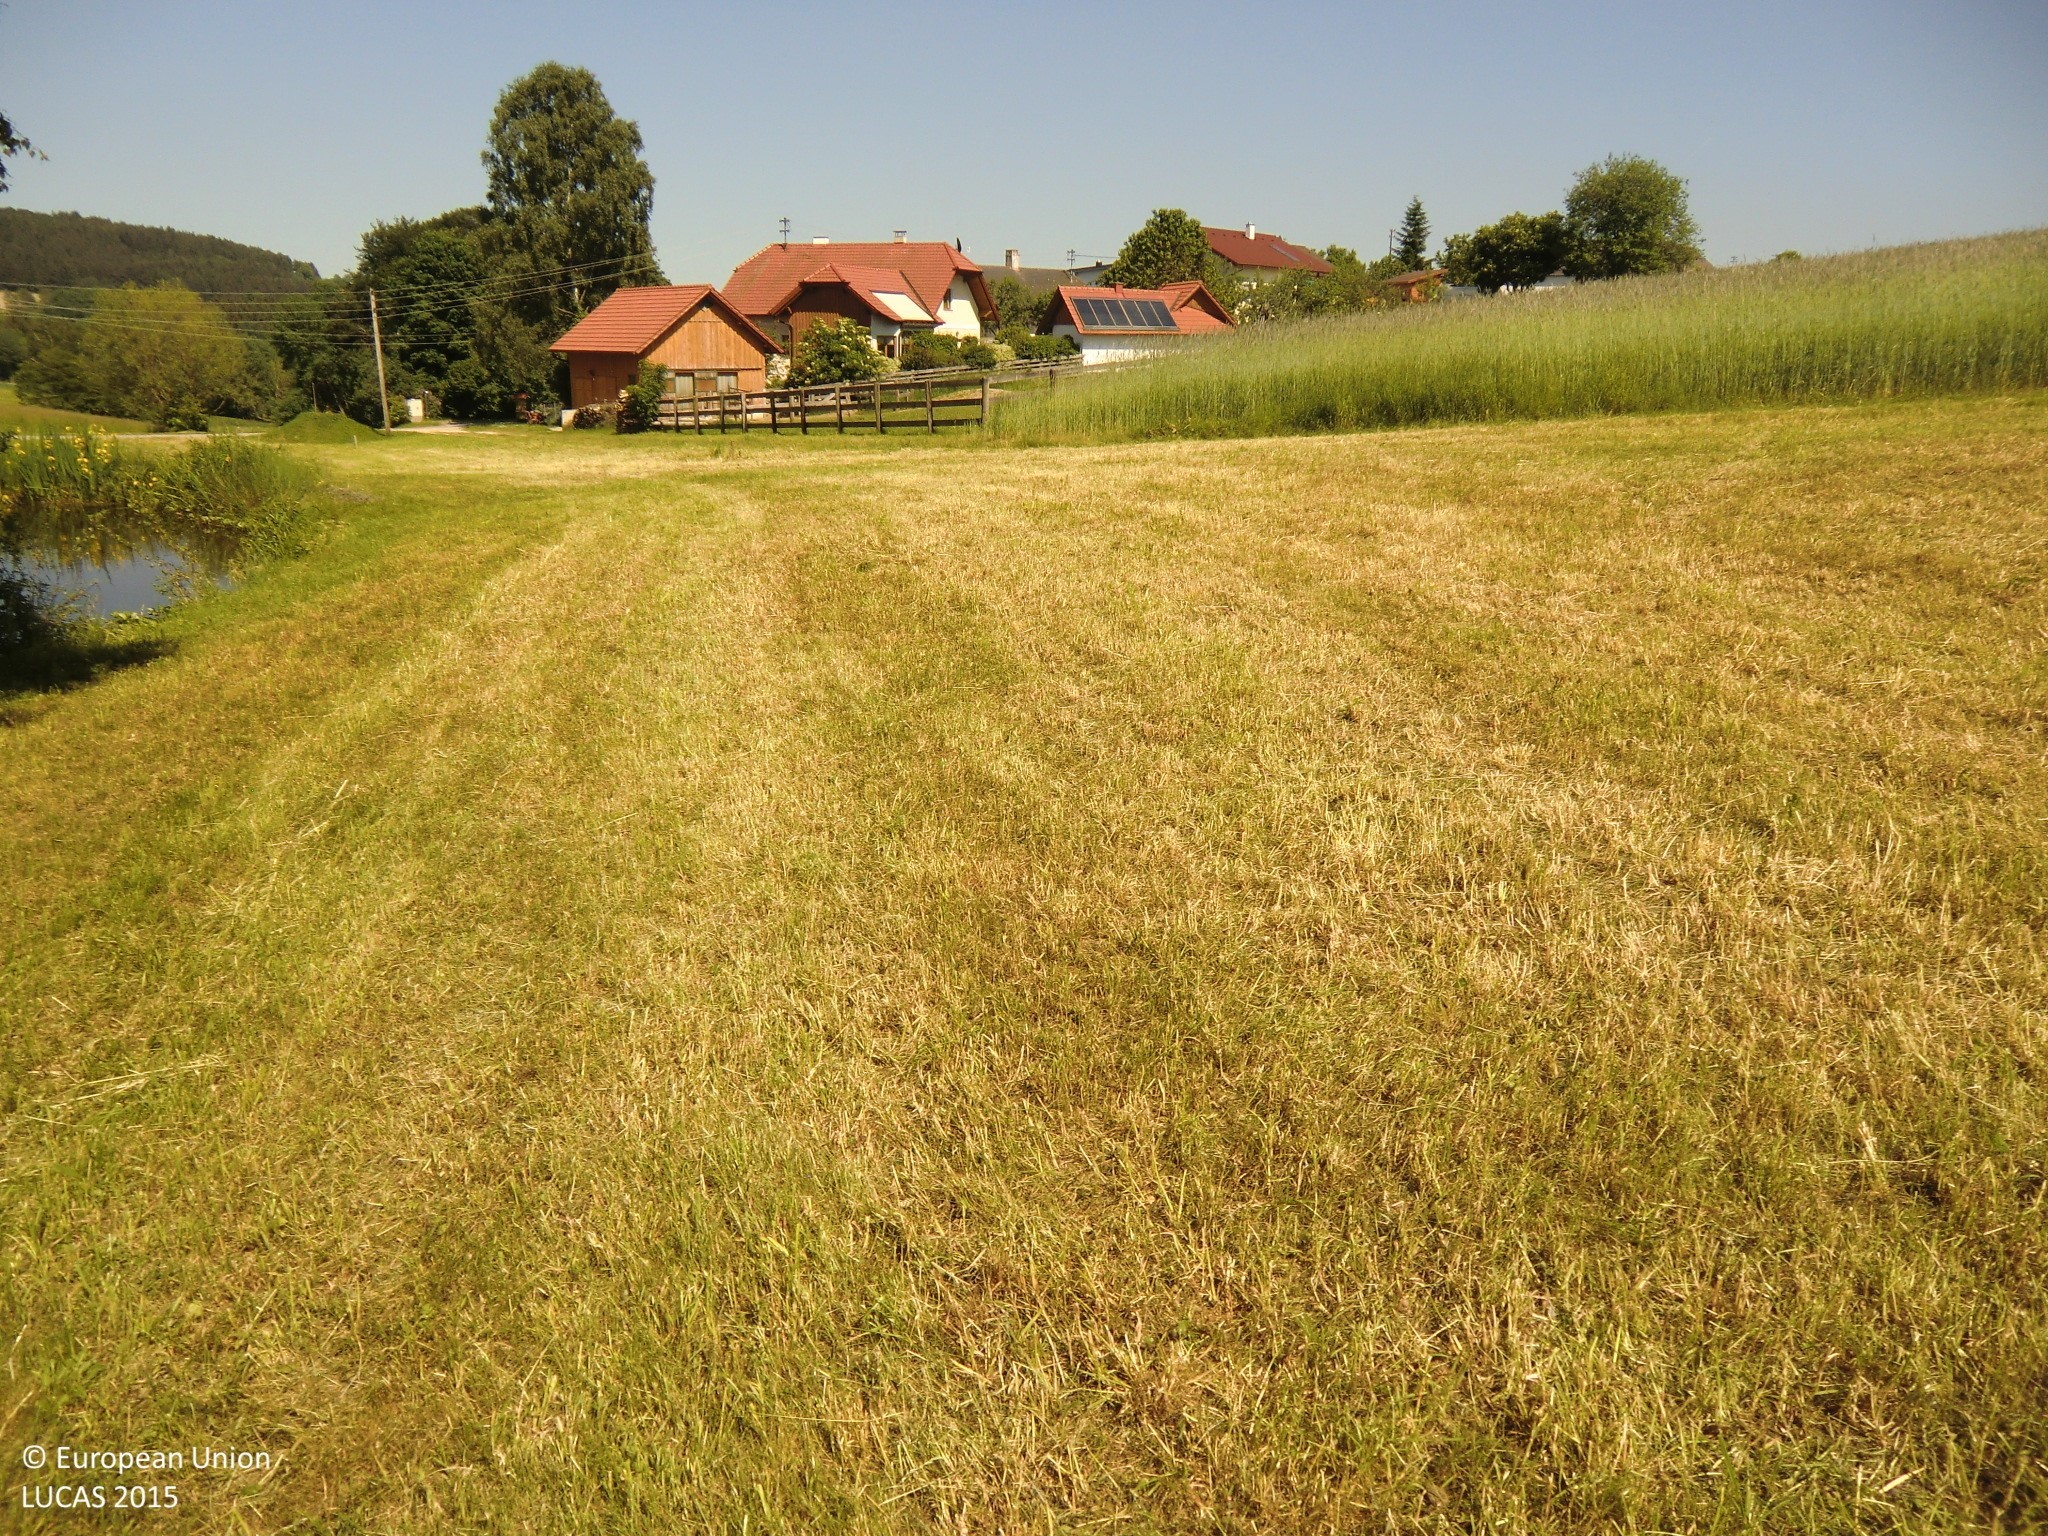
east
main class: Grassland
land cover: Grassland with sparse tree/shrub cover
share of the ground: > 75 %
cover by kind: herbaceous plants 95 %, broadleaved forest trees 5 %
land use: Agriculture (excluding fallow land and kitchen gardens)
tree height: > 5 m
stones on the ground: < 10 %
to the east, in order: Grassland with sparse tree/shrub cover; Grassland without tree/shrub cover; Artificial constructions in urban areas; Grassland without tree/shrub cover; Tracks; Fences; Grassland without tree/shrub cover; Electric lines; Grassland without tree/shrub cover; Fences; Tracks; Grassland without tree/shrub cover
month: June
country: AT
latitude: 48.5321
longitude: 14.4018
